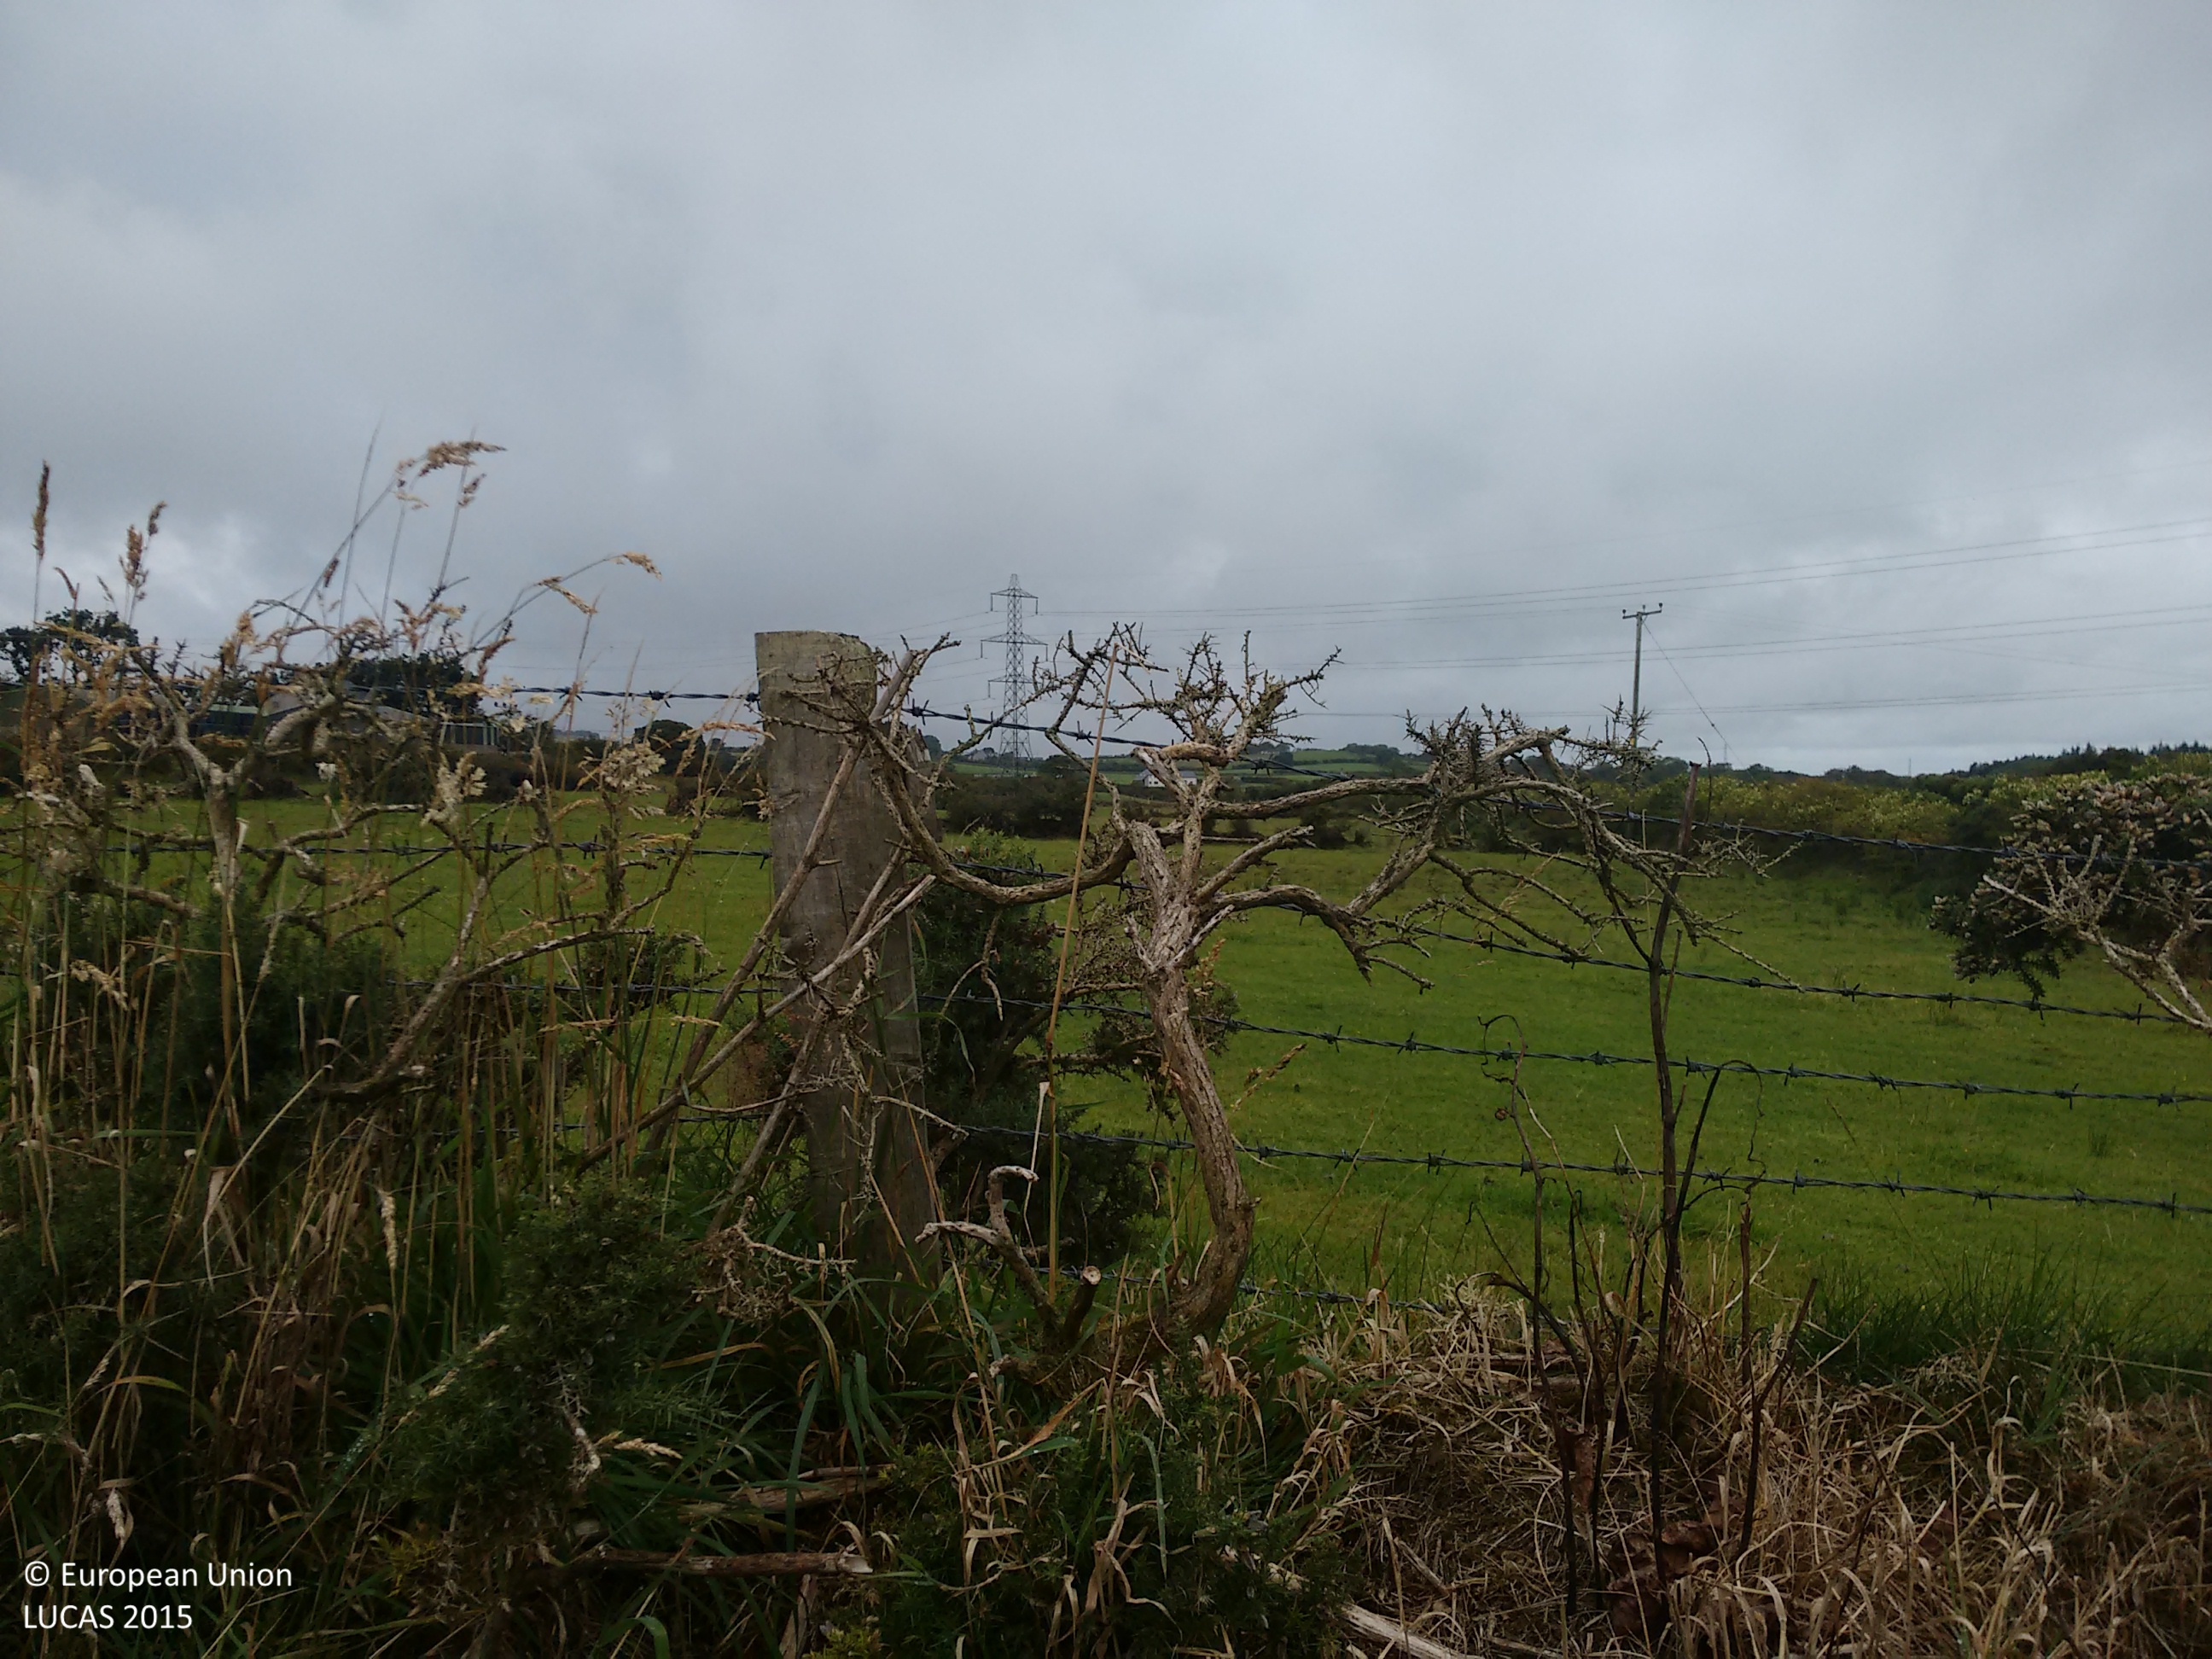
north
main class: Grassland
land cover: Grassland without tree/shrub cover
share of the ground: > 75 %
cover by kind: herbaceous plants 100 %
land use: Agriculture (excluding fallow land and kitchen gardens)
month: September
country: GB
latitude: 54.7571
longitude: -5.8141
